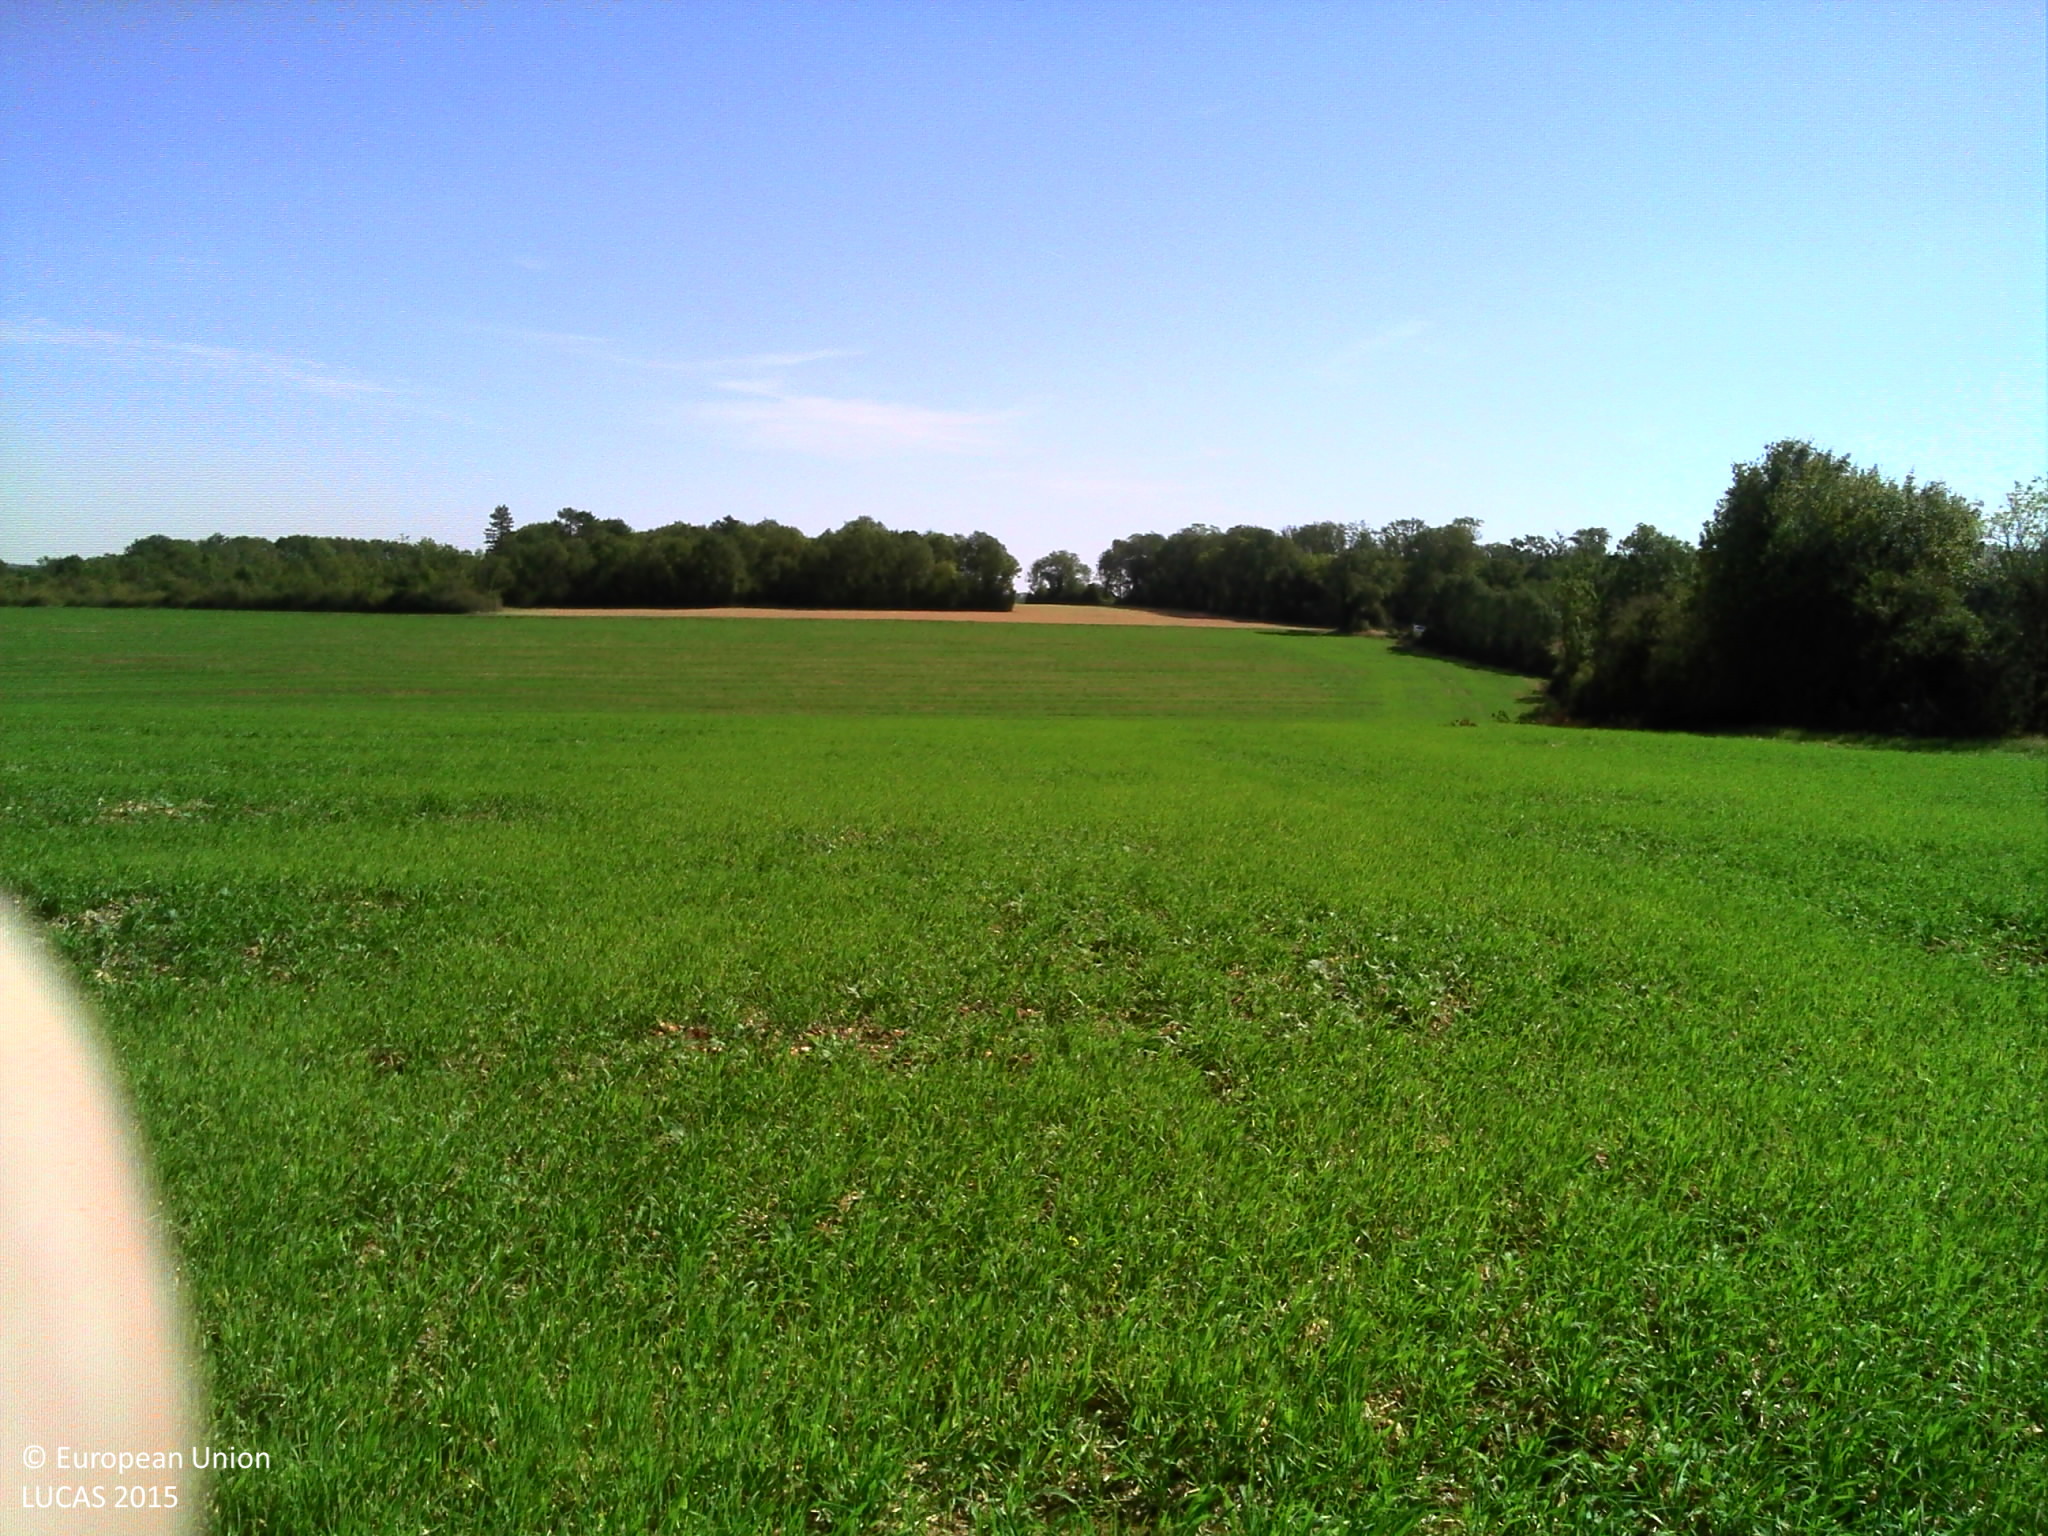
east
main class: Cropland
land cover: Barley
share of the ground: > 75 %
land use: Agriculture (excluding fallow land and kitchen gardens)
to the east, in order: Barley
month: September
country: FR
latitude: 47.5569
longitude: 4.3772
